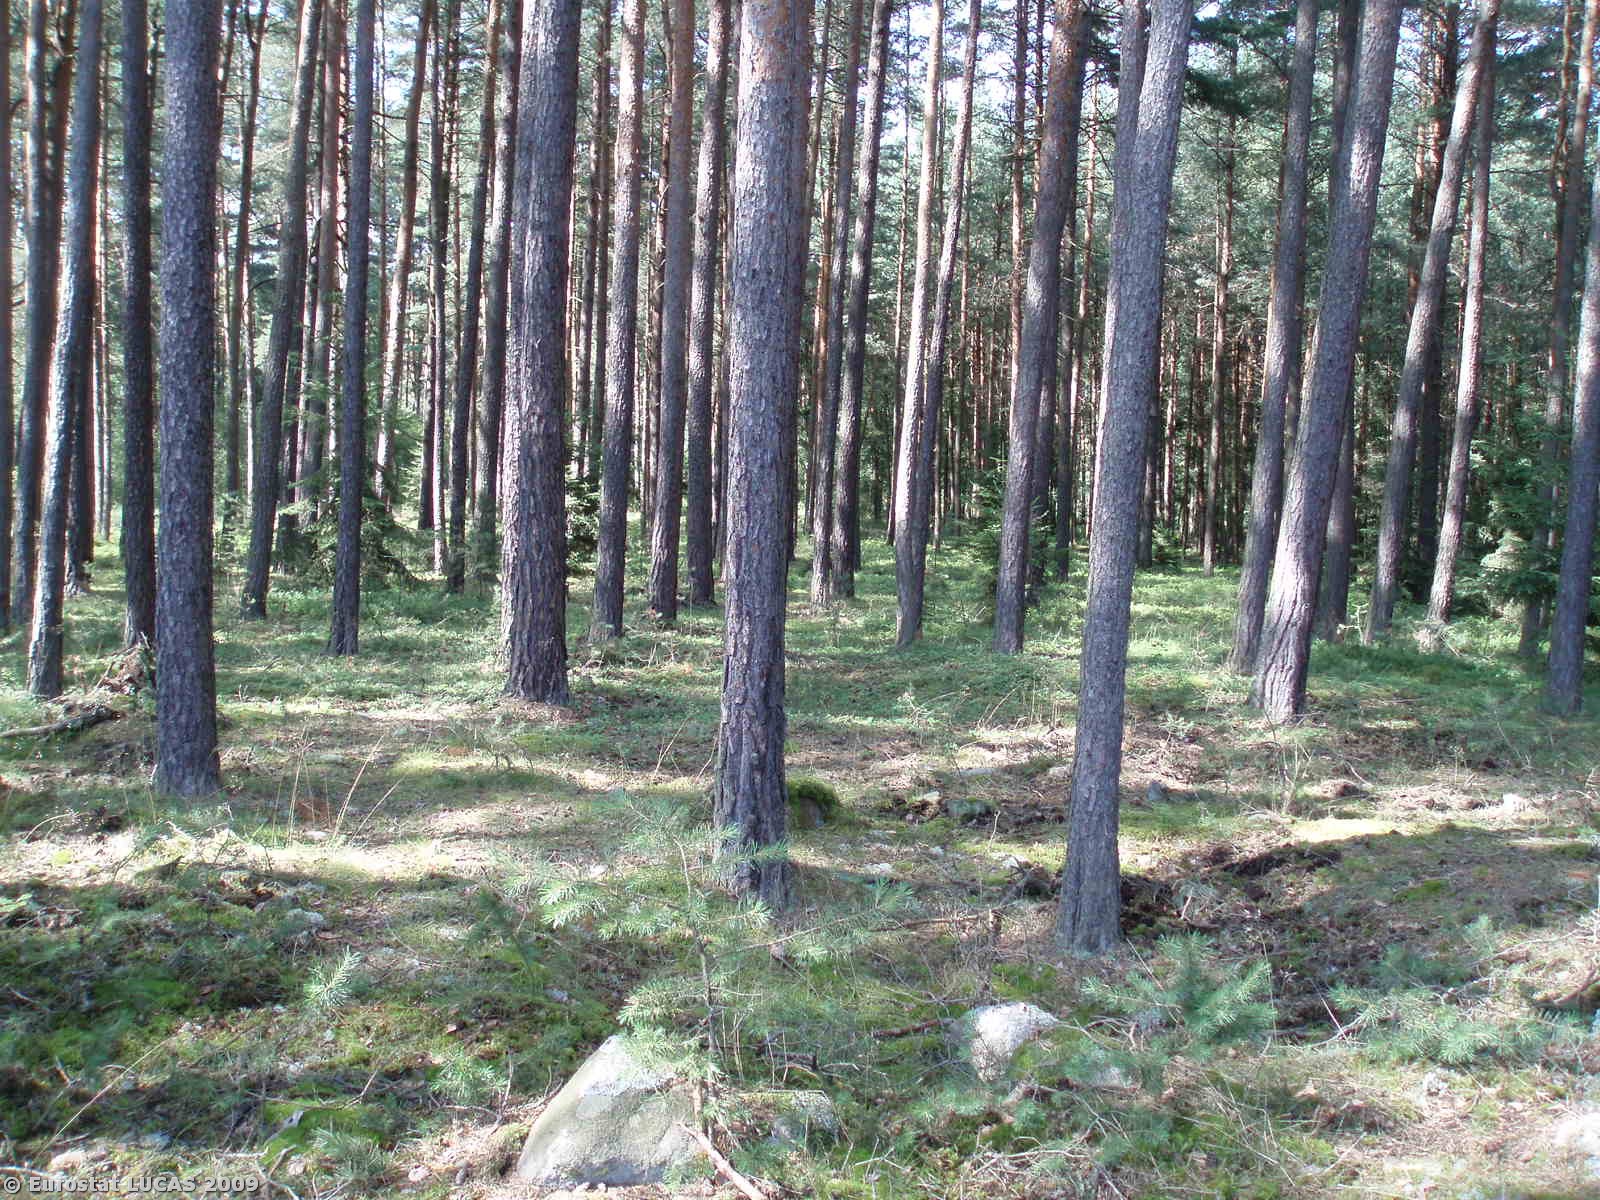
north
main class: Woodland
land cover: Coniferous woodland
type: hemiboreal forest and nemoral coniferous forest and mixed broadleaved-coniferous forest
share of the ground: > 75 %
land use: Forestry
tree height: > 5 m
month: July
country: CZ
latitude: 49.6796
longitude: 12.8963
